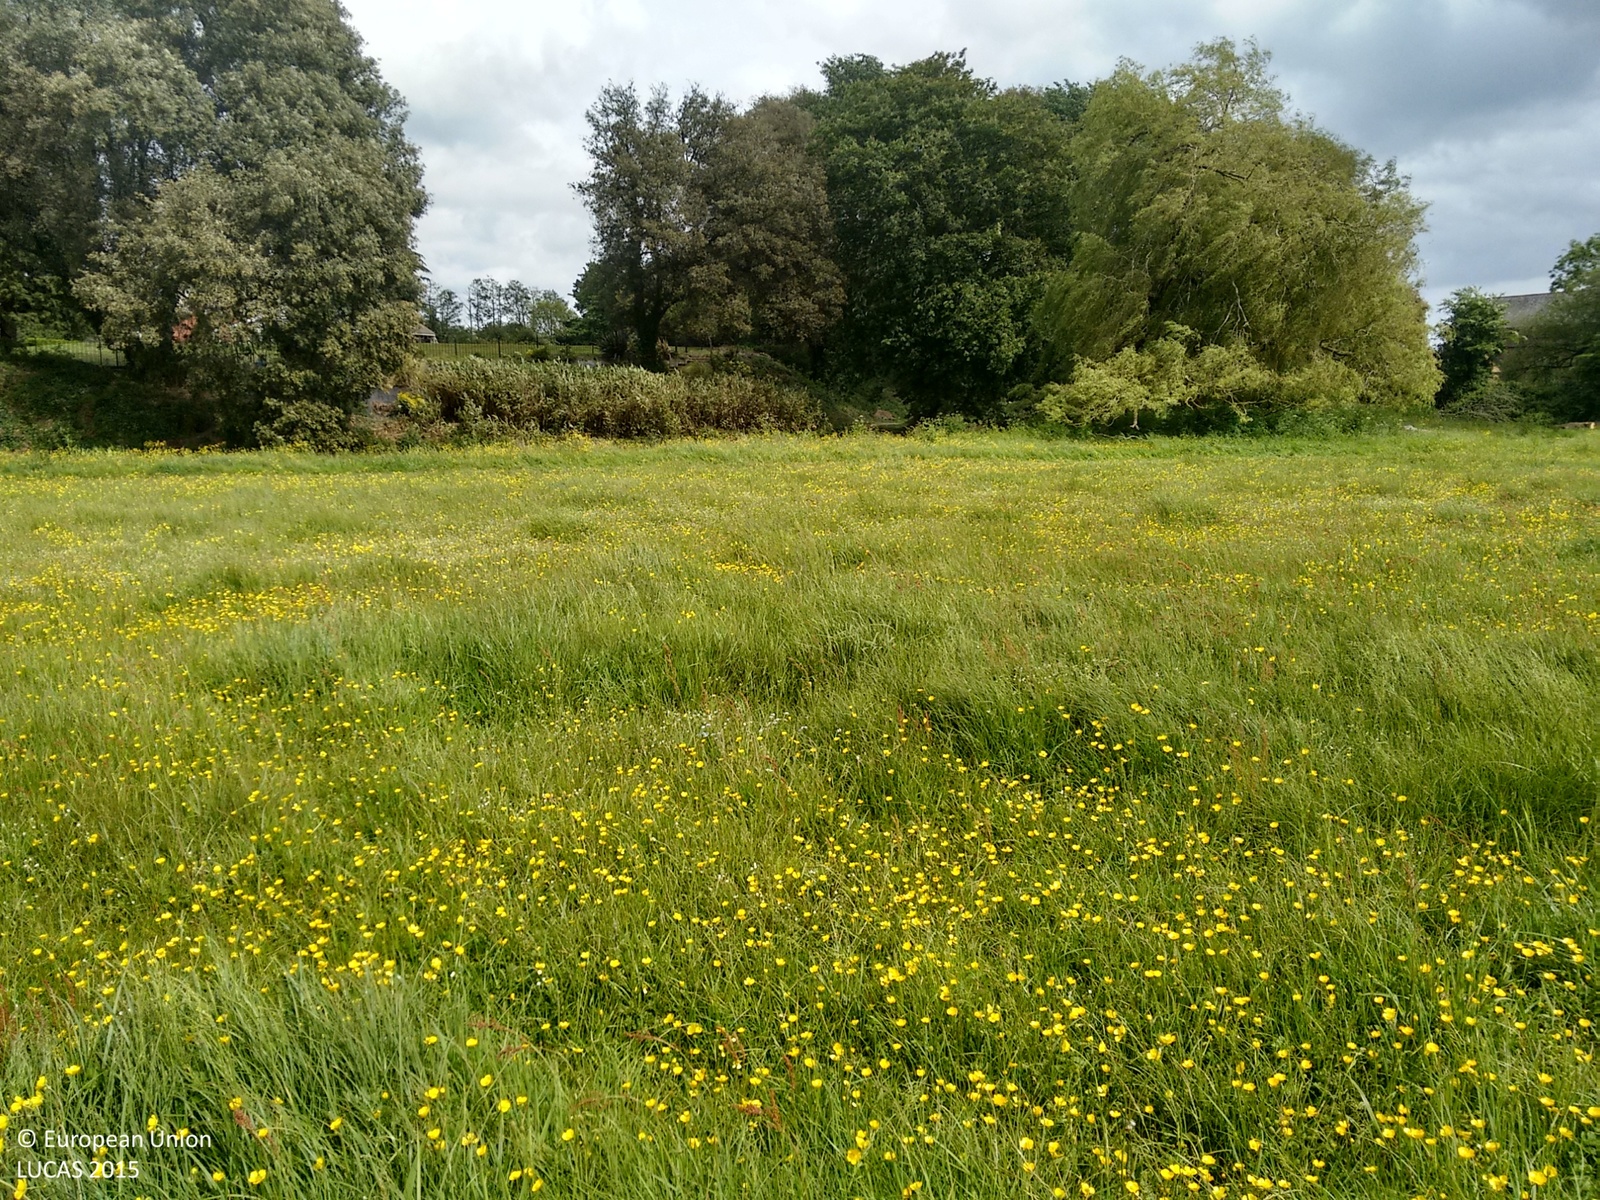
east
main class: Grassland
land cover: Grassland without tree/shrub cover
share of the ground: > 75 %
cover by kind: herbaceous plants 100 %
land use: Agriculture (excluding fallow land and kitchen gardens)
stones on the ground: < 10 %
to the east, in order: Grassland without tree/shrub cover; Inland fresh running water; Shruby margins; Artificial constructions in urban areas; Inland fresh running water; Artificial constructions in urban areas
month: May
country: GB
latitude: 50.7705
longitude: -1.7815
